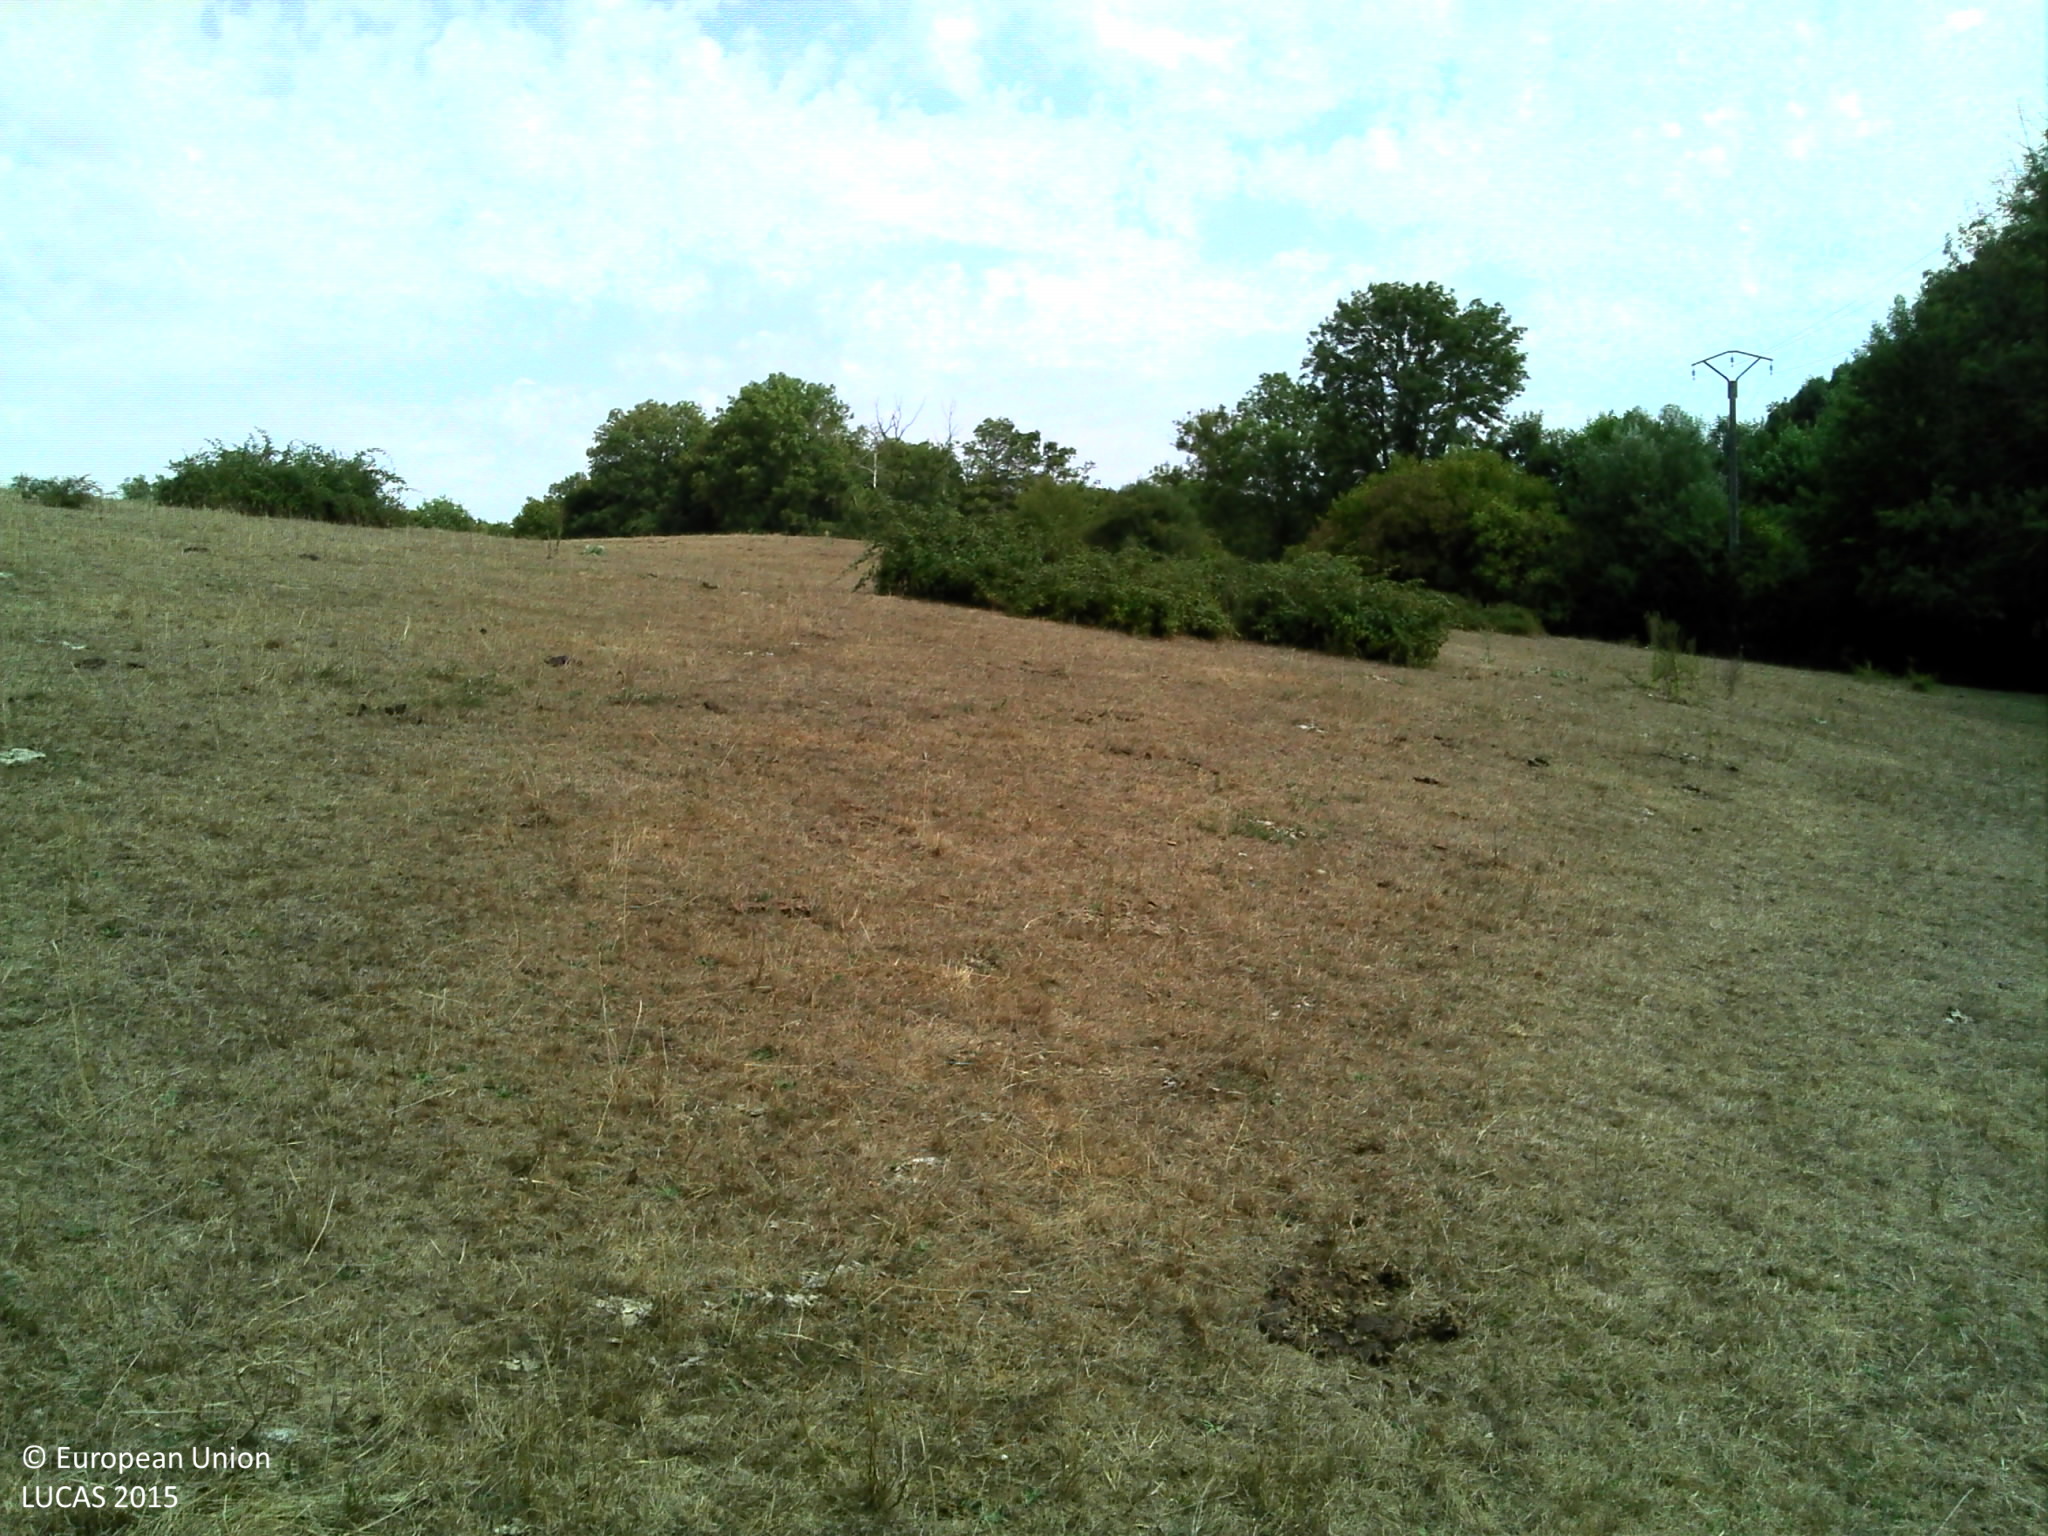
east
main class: Grassland
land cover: Grassland without tree/shrub cover
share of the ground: > 75 %
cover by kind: herbaceous plants 95 %, shrubs 5 %
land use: Agriculture (excluding fallow land and kitchen gardens)
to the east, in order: Grassland without tree/shrub cover; Broadleaved woodland; Fences; Grass margins; Paved roads, cycling and walking lanes; Grass margins; Ditches and canals; Electric lines; Grass margins; Managed hedges
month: August
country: FR
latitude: 47.7738
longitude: 3.1216
